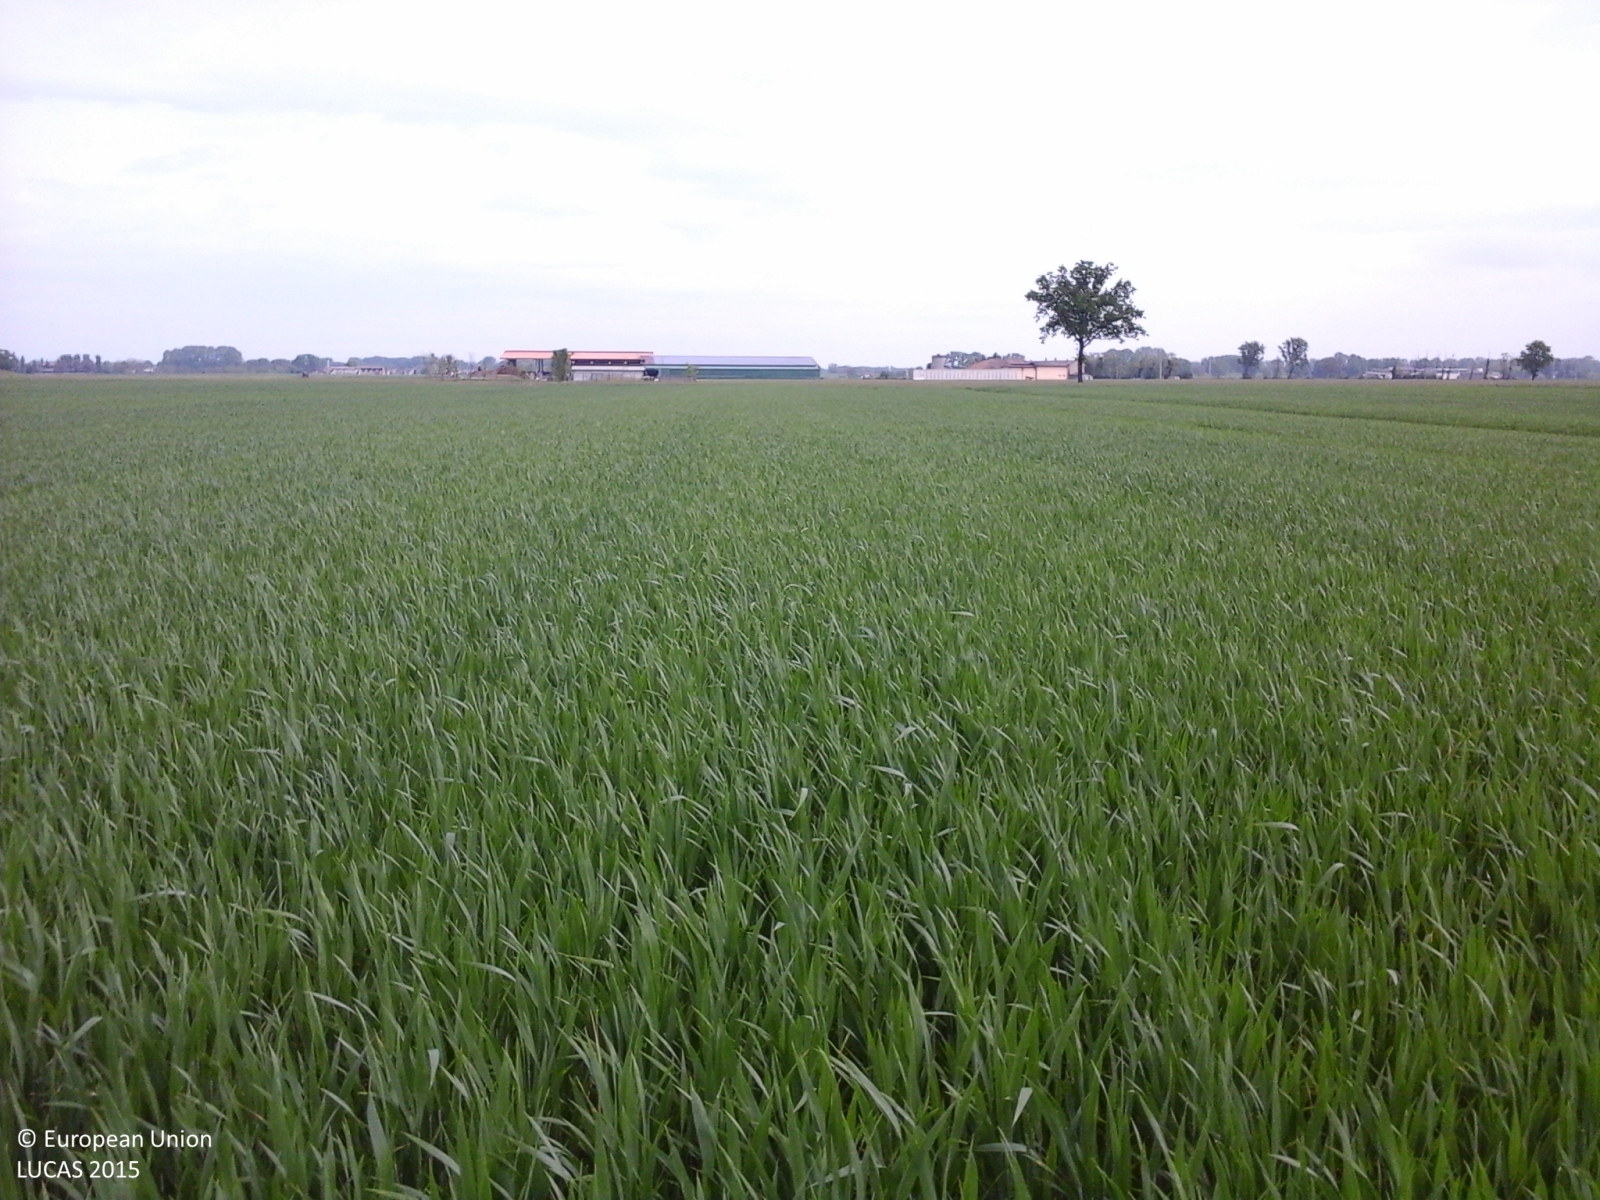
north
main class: Cropland
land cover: Common wheat
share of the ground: > 75 %
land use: Agriculture (excluding fallow land and kitchen gardens)
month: April
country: IT
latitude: 45.0889
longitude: 9.5562
